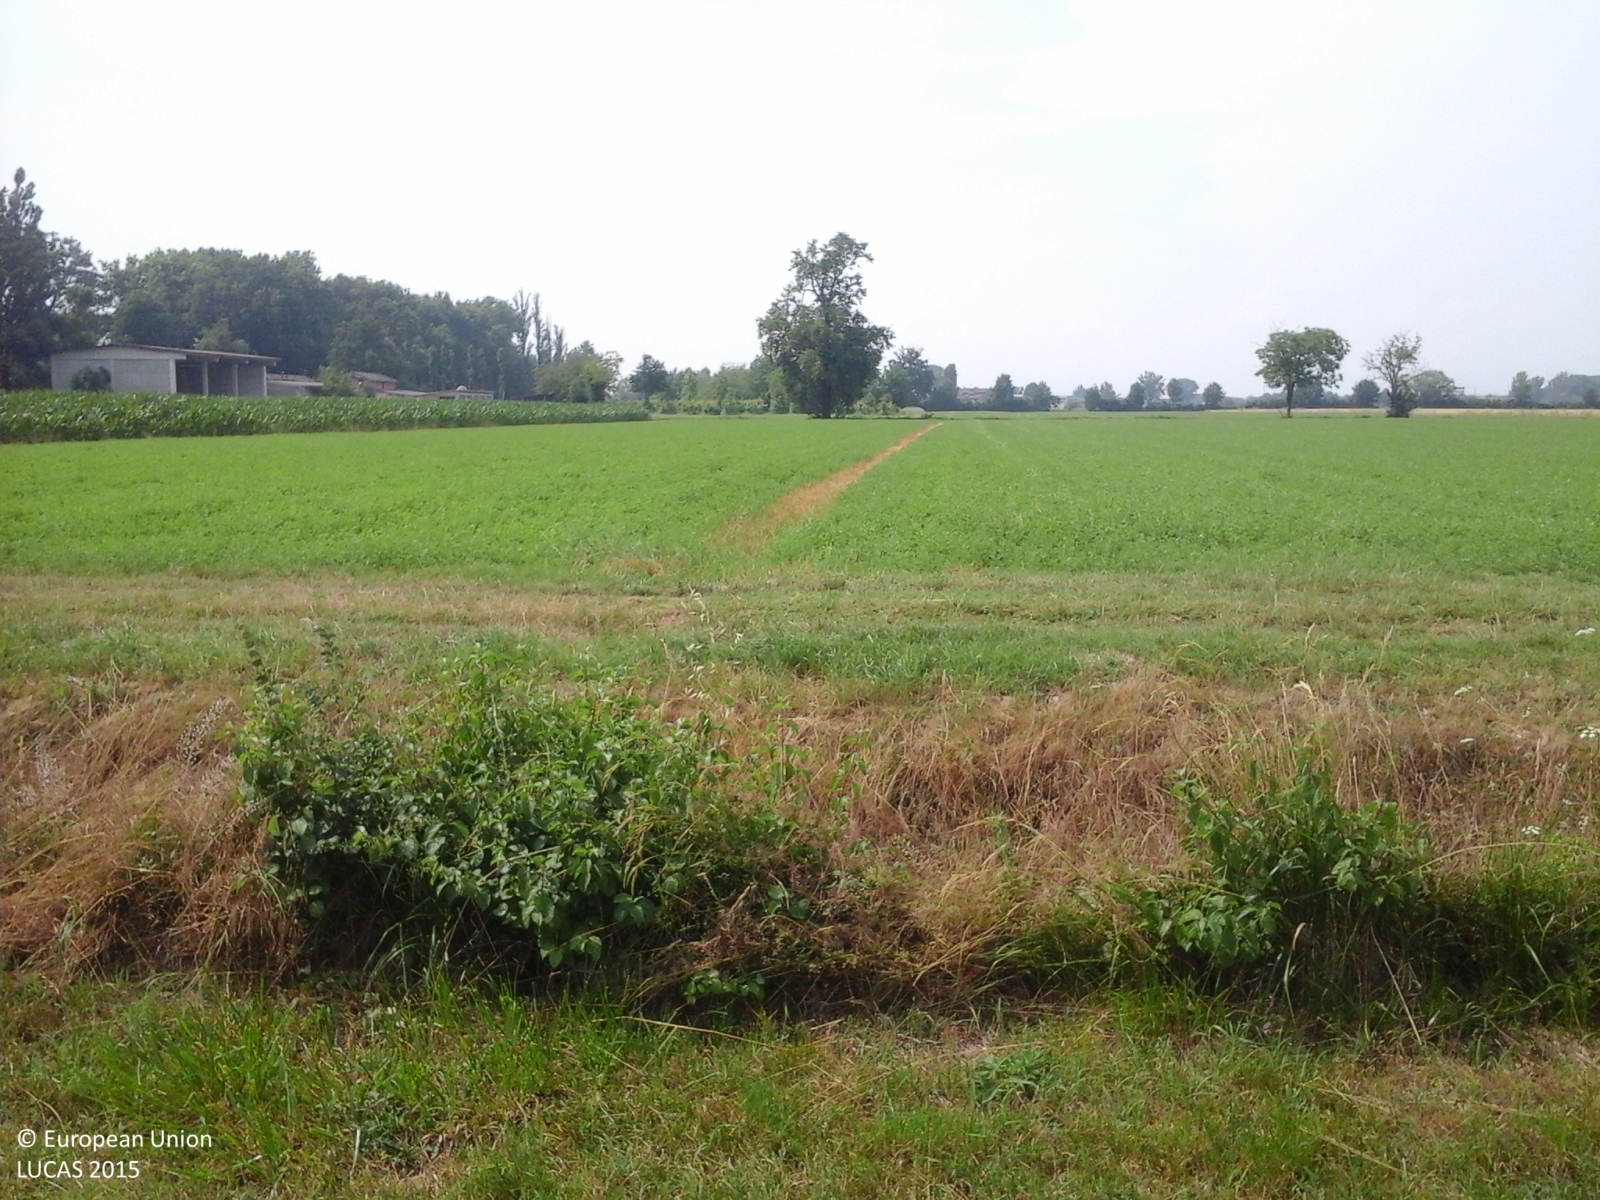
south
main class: Cropland
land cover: Maize
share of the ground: > 75 %
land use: Agriculture (excluding fallow land and kitchen gardens)
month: June
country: IT
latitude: 44.8006
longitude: 10.3911
